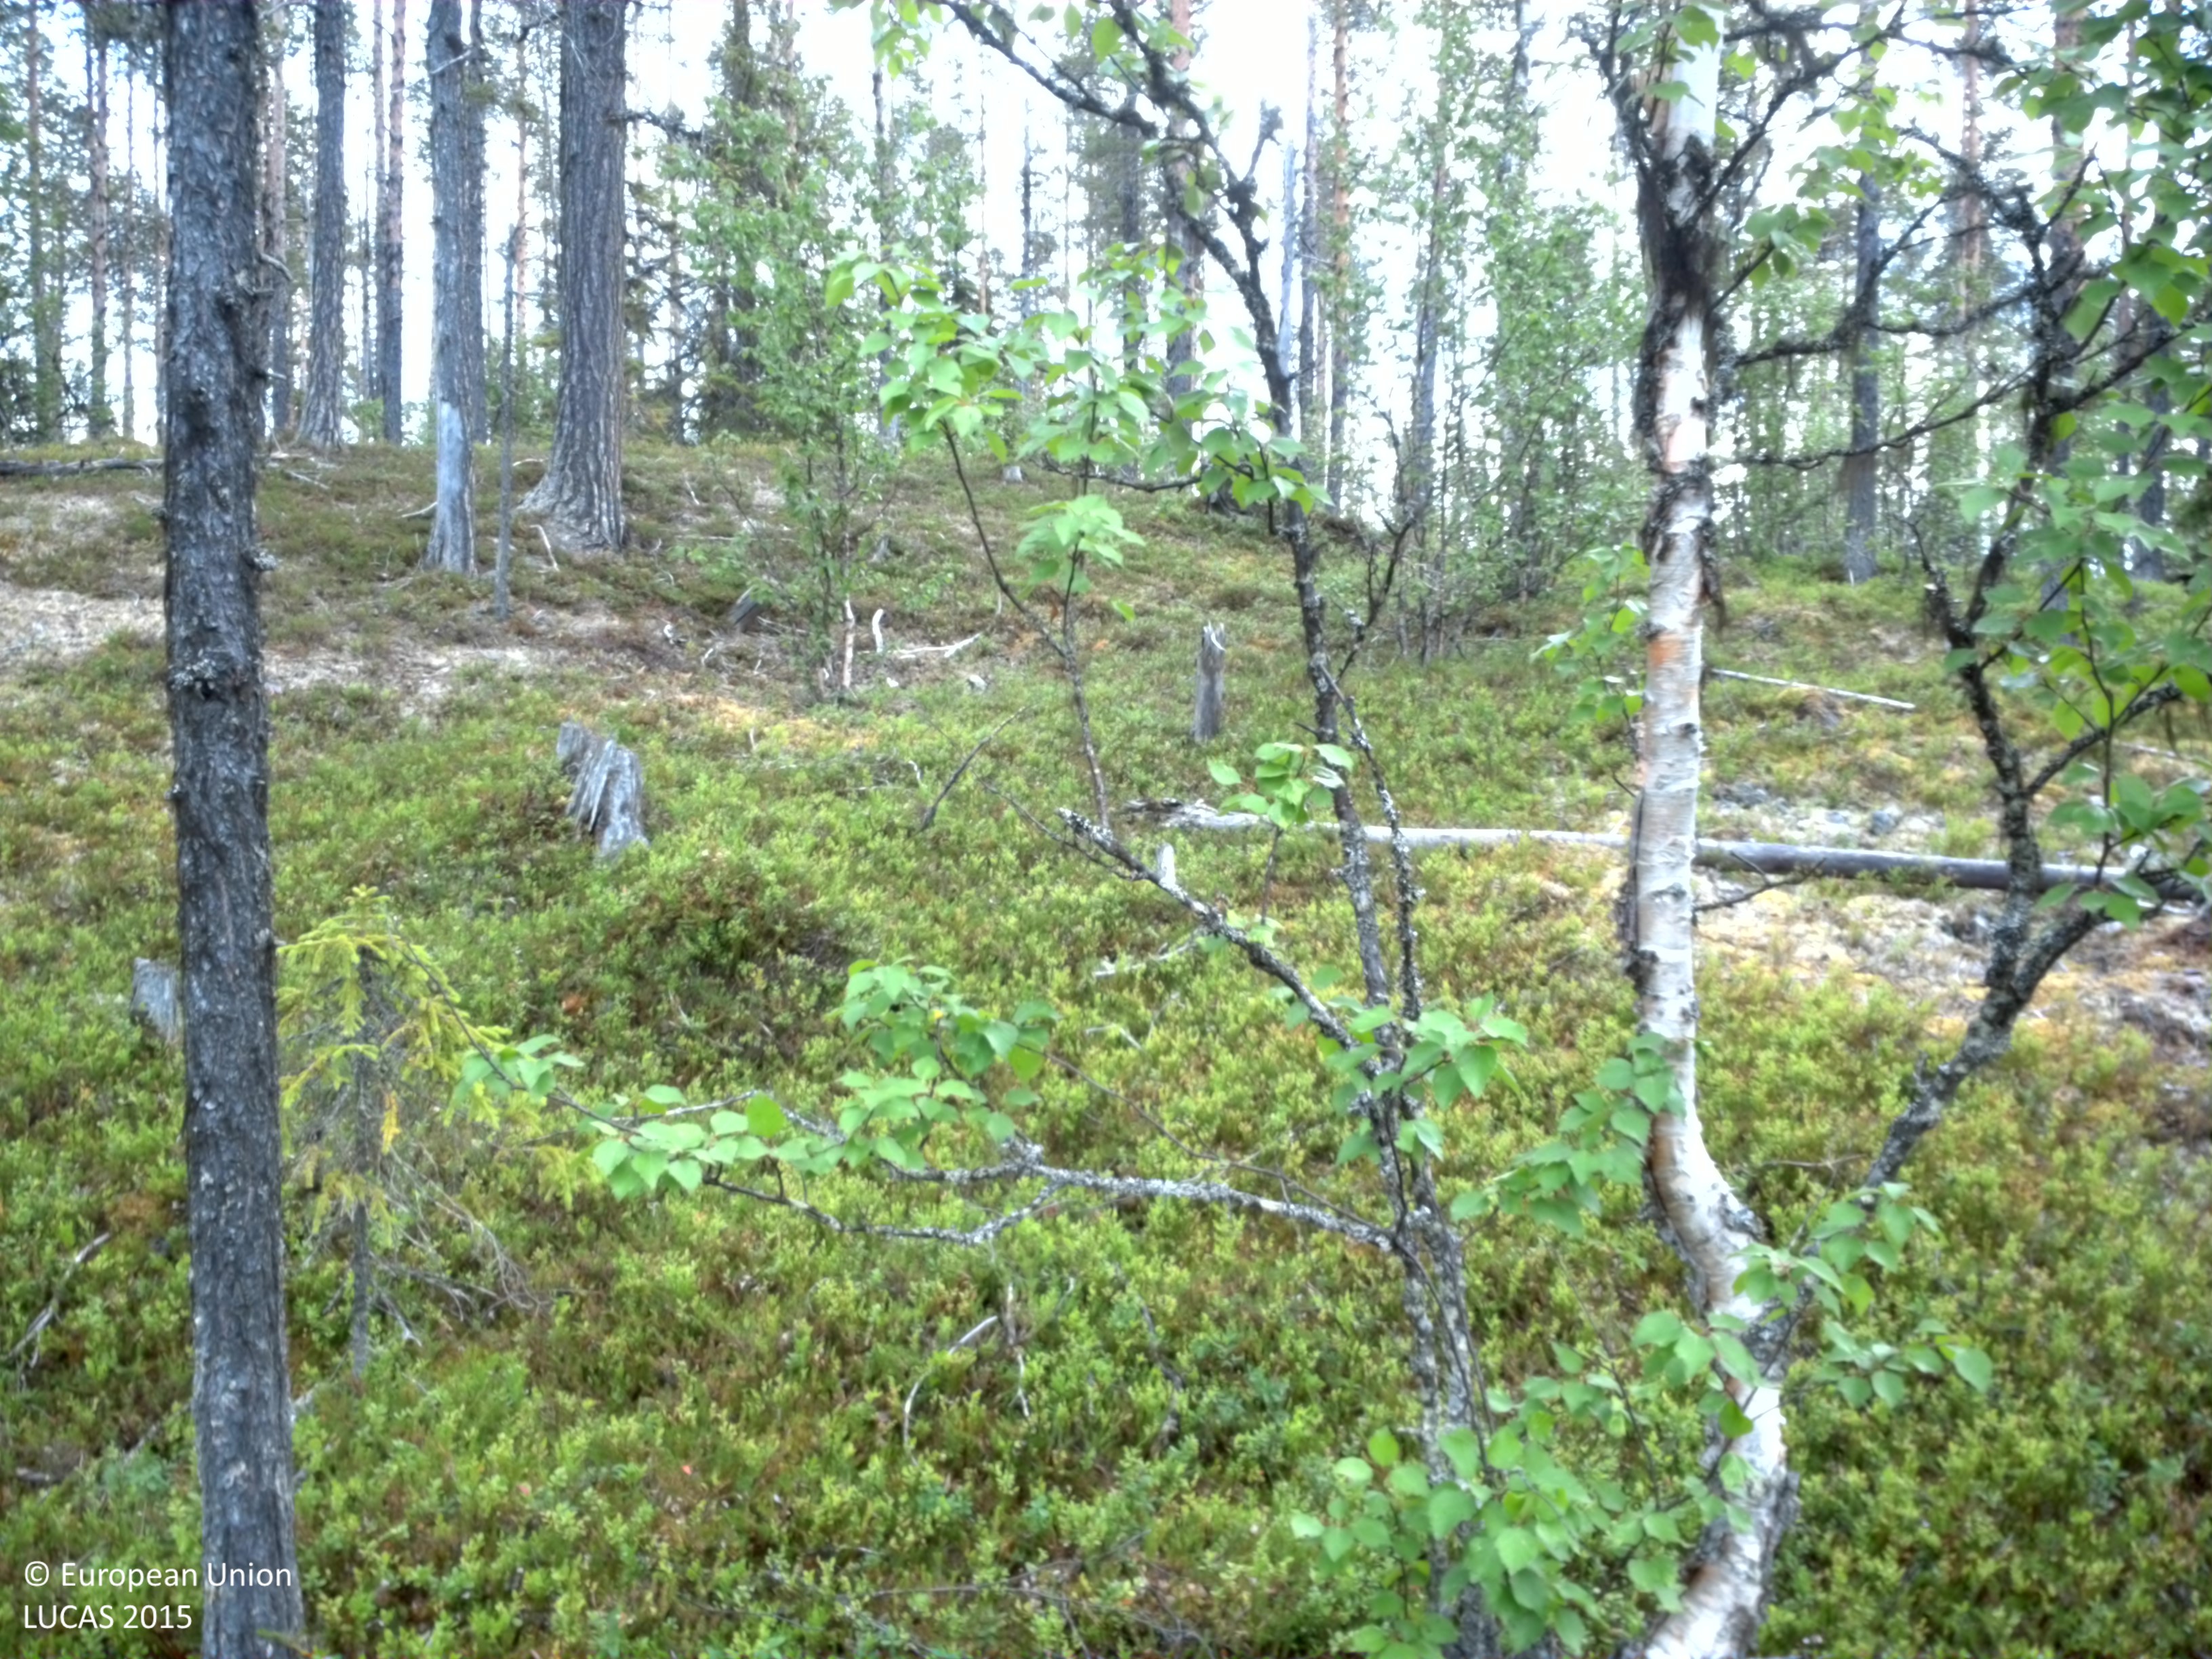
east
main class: Woodland
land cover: Pine dominated mixed woodland
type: boreal forest
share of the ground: 10 - 25 %
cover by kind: shrubs 40 %, lichens and mosses 30 %, coniferous forest trees 20 %, broadleaved forest trees 10 %
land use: Forestry
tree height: > 5 m
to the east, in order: Pine dominated mixed woodland; Spruce dominated mixed woodland; Pine dominated mixed woodland
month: August
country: SE
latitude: 65.0762
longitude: 16.1538
